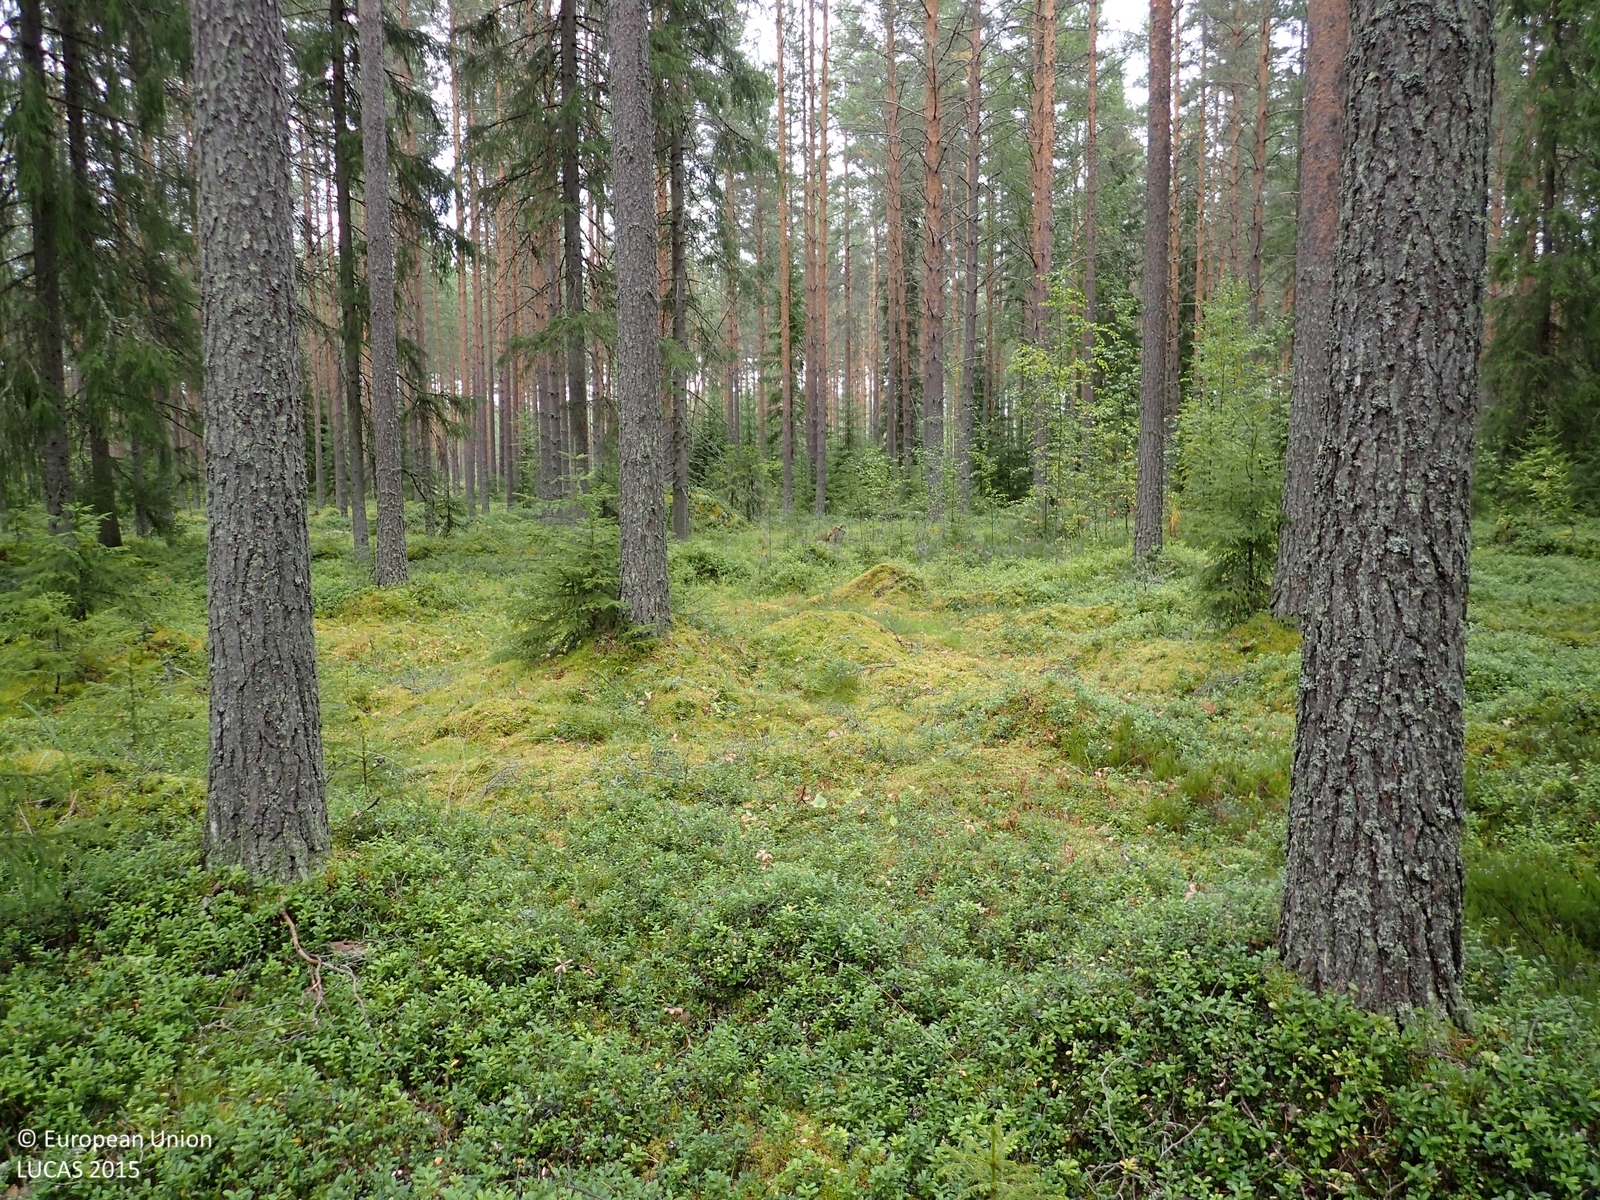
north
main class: Woodland
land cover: Other coniferous woodland
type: boreal forest
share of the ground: 50 - 75 %
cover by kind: coniferous forest trees 70 %, shrubs 20 %, lichens and mosses 10 %
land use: Forestry
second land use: Amenities, museums, leisure
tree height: > 5 m
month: August
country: FI
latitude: 62.7476
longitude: 22.7218
